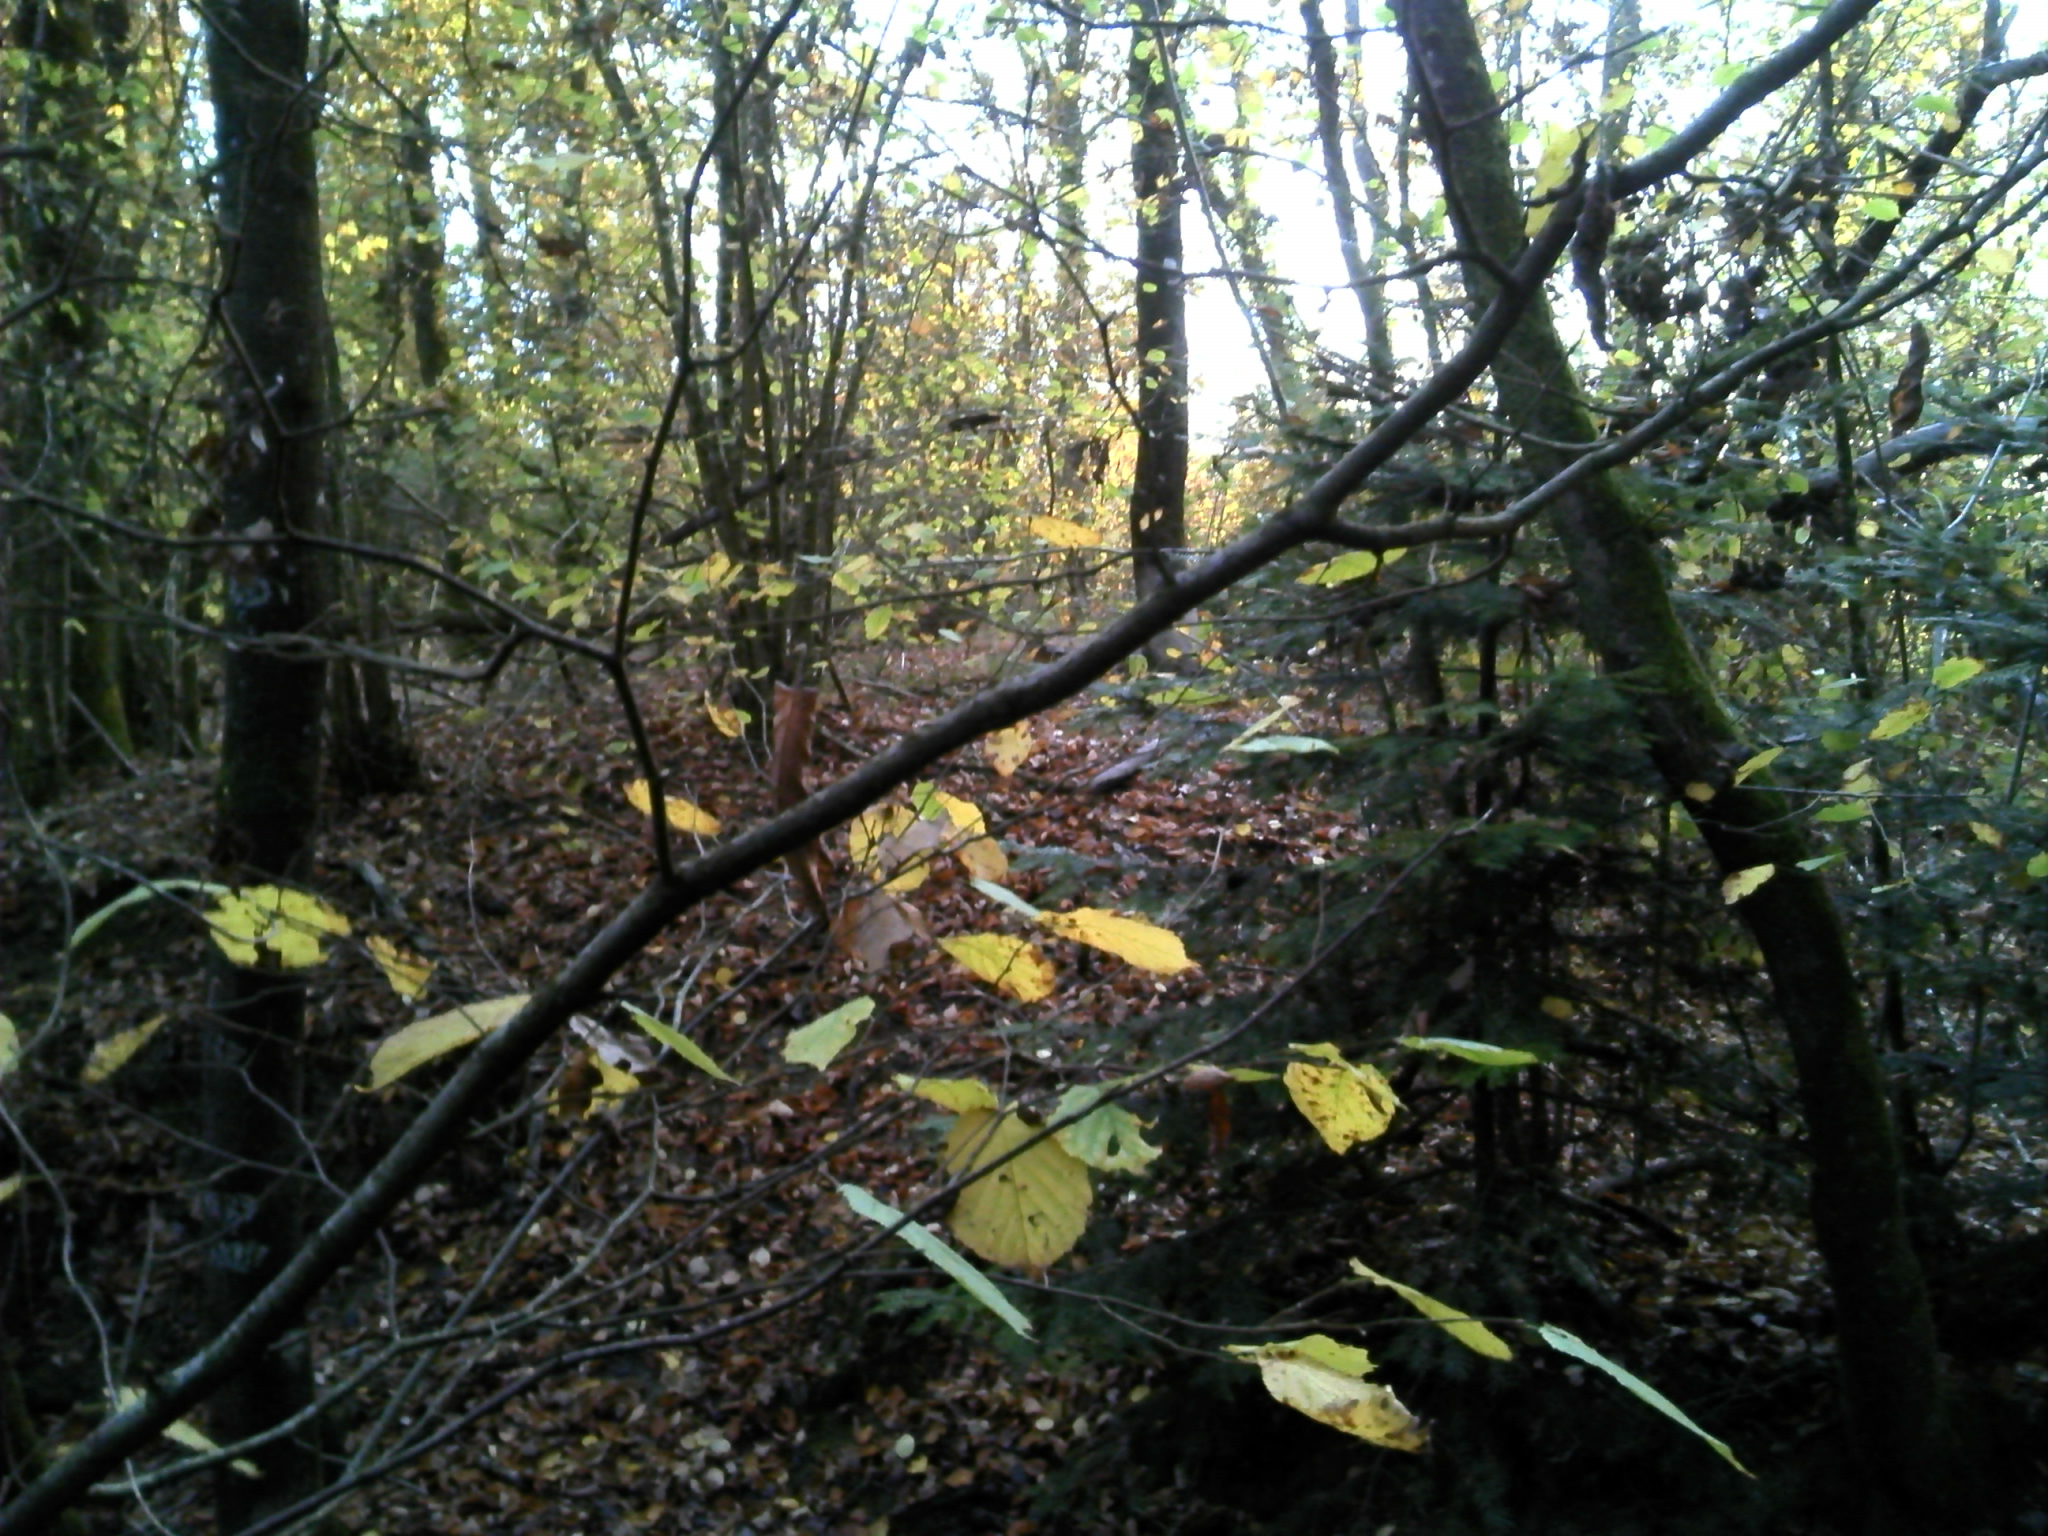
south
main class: Woodland
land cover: Other mixed woodland
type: hemiboreal forest and nemoral coniferous forest and mixed broadleaved-coniferous forest
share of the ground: > 75 %
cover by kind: coniferous forest trees 50 %, broadleaved forest trees 50 %
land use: Forestry
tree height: > 5 m
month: November
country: FR
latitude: 47.7372
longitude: -1.0667
